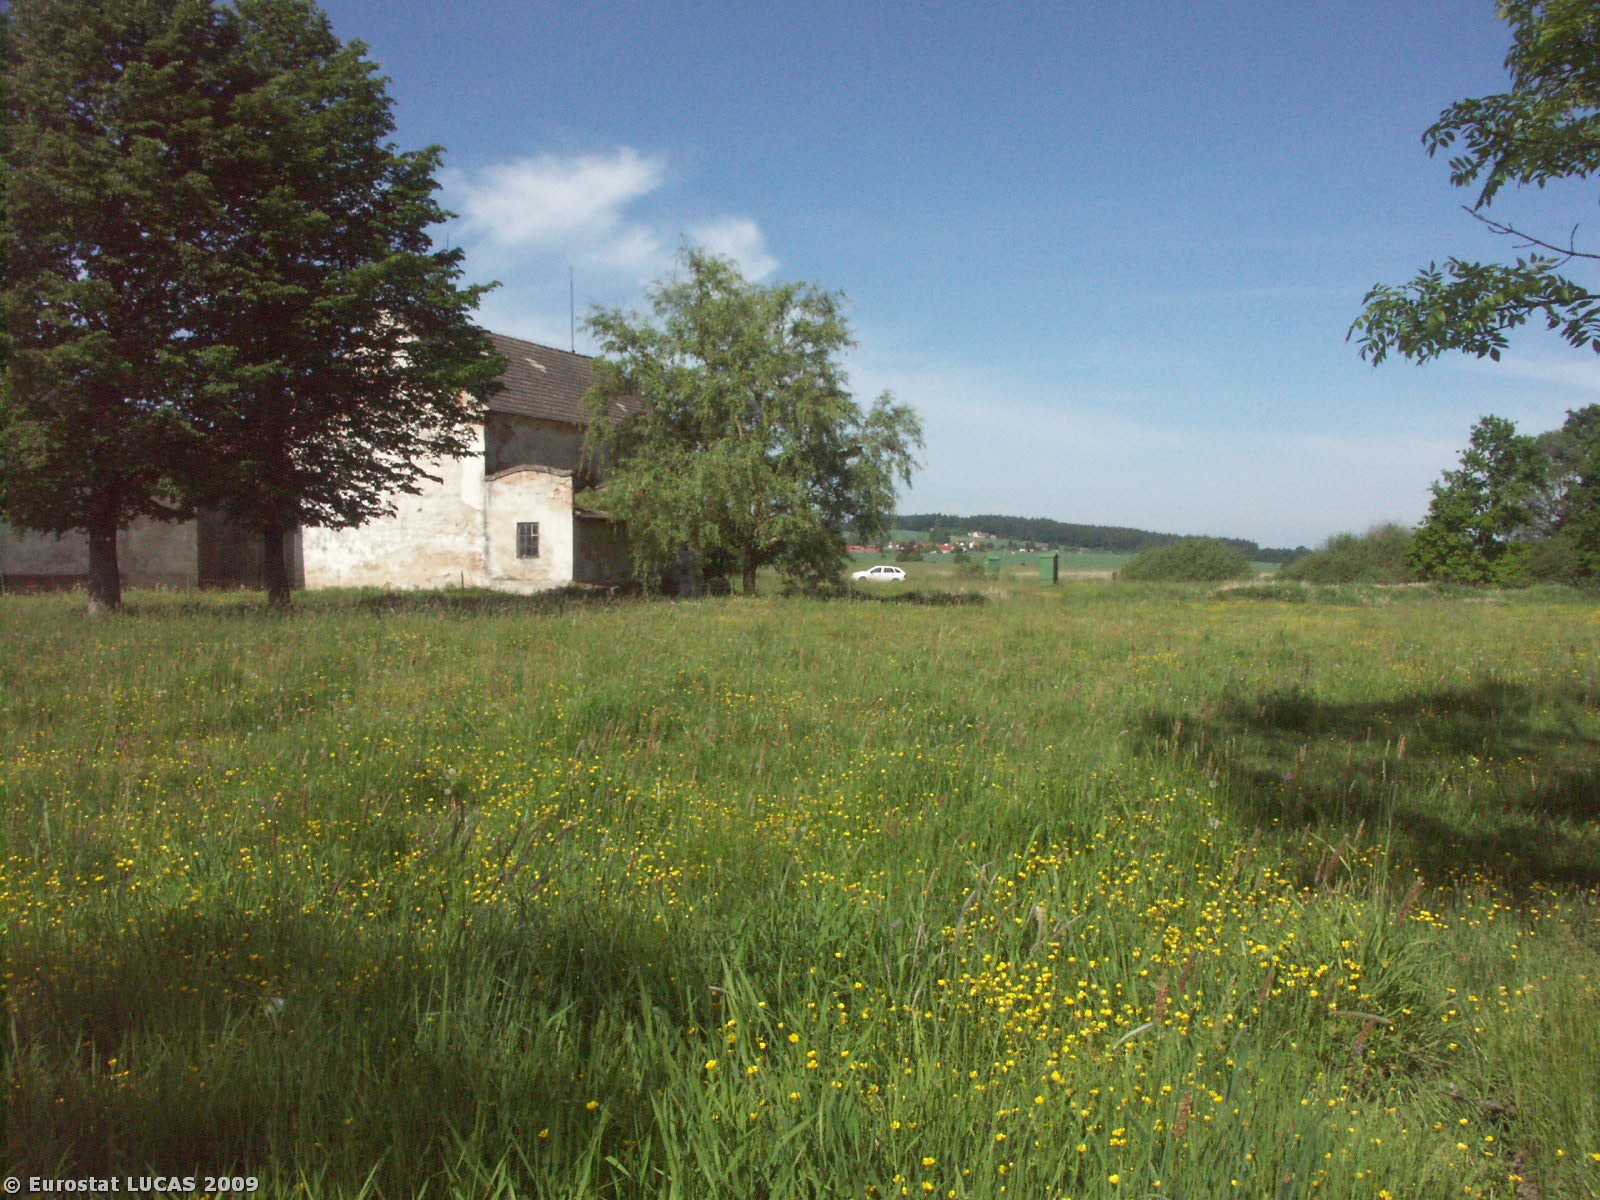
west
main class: Woodland
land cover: Broadleaved woodland
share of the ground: > 75 %
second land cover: Grassland with sparse tree/shrub cover
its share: > 75 %
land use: Nature reserves
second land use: Agriculture (excluding fallow land and kitchen gardens)
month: May
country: CZ
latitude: 48.8812
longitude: 14.6786
